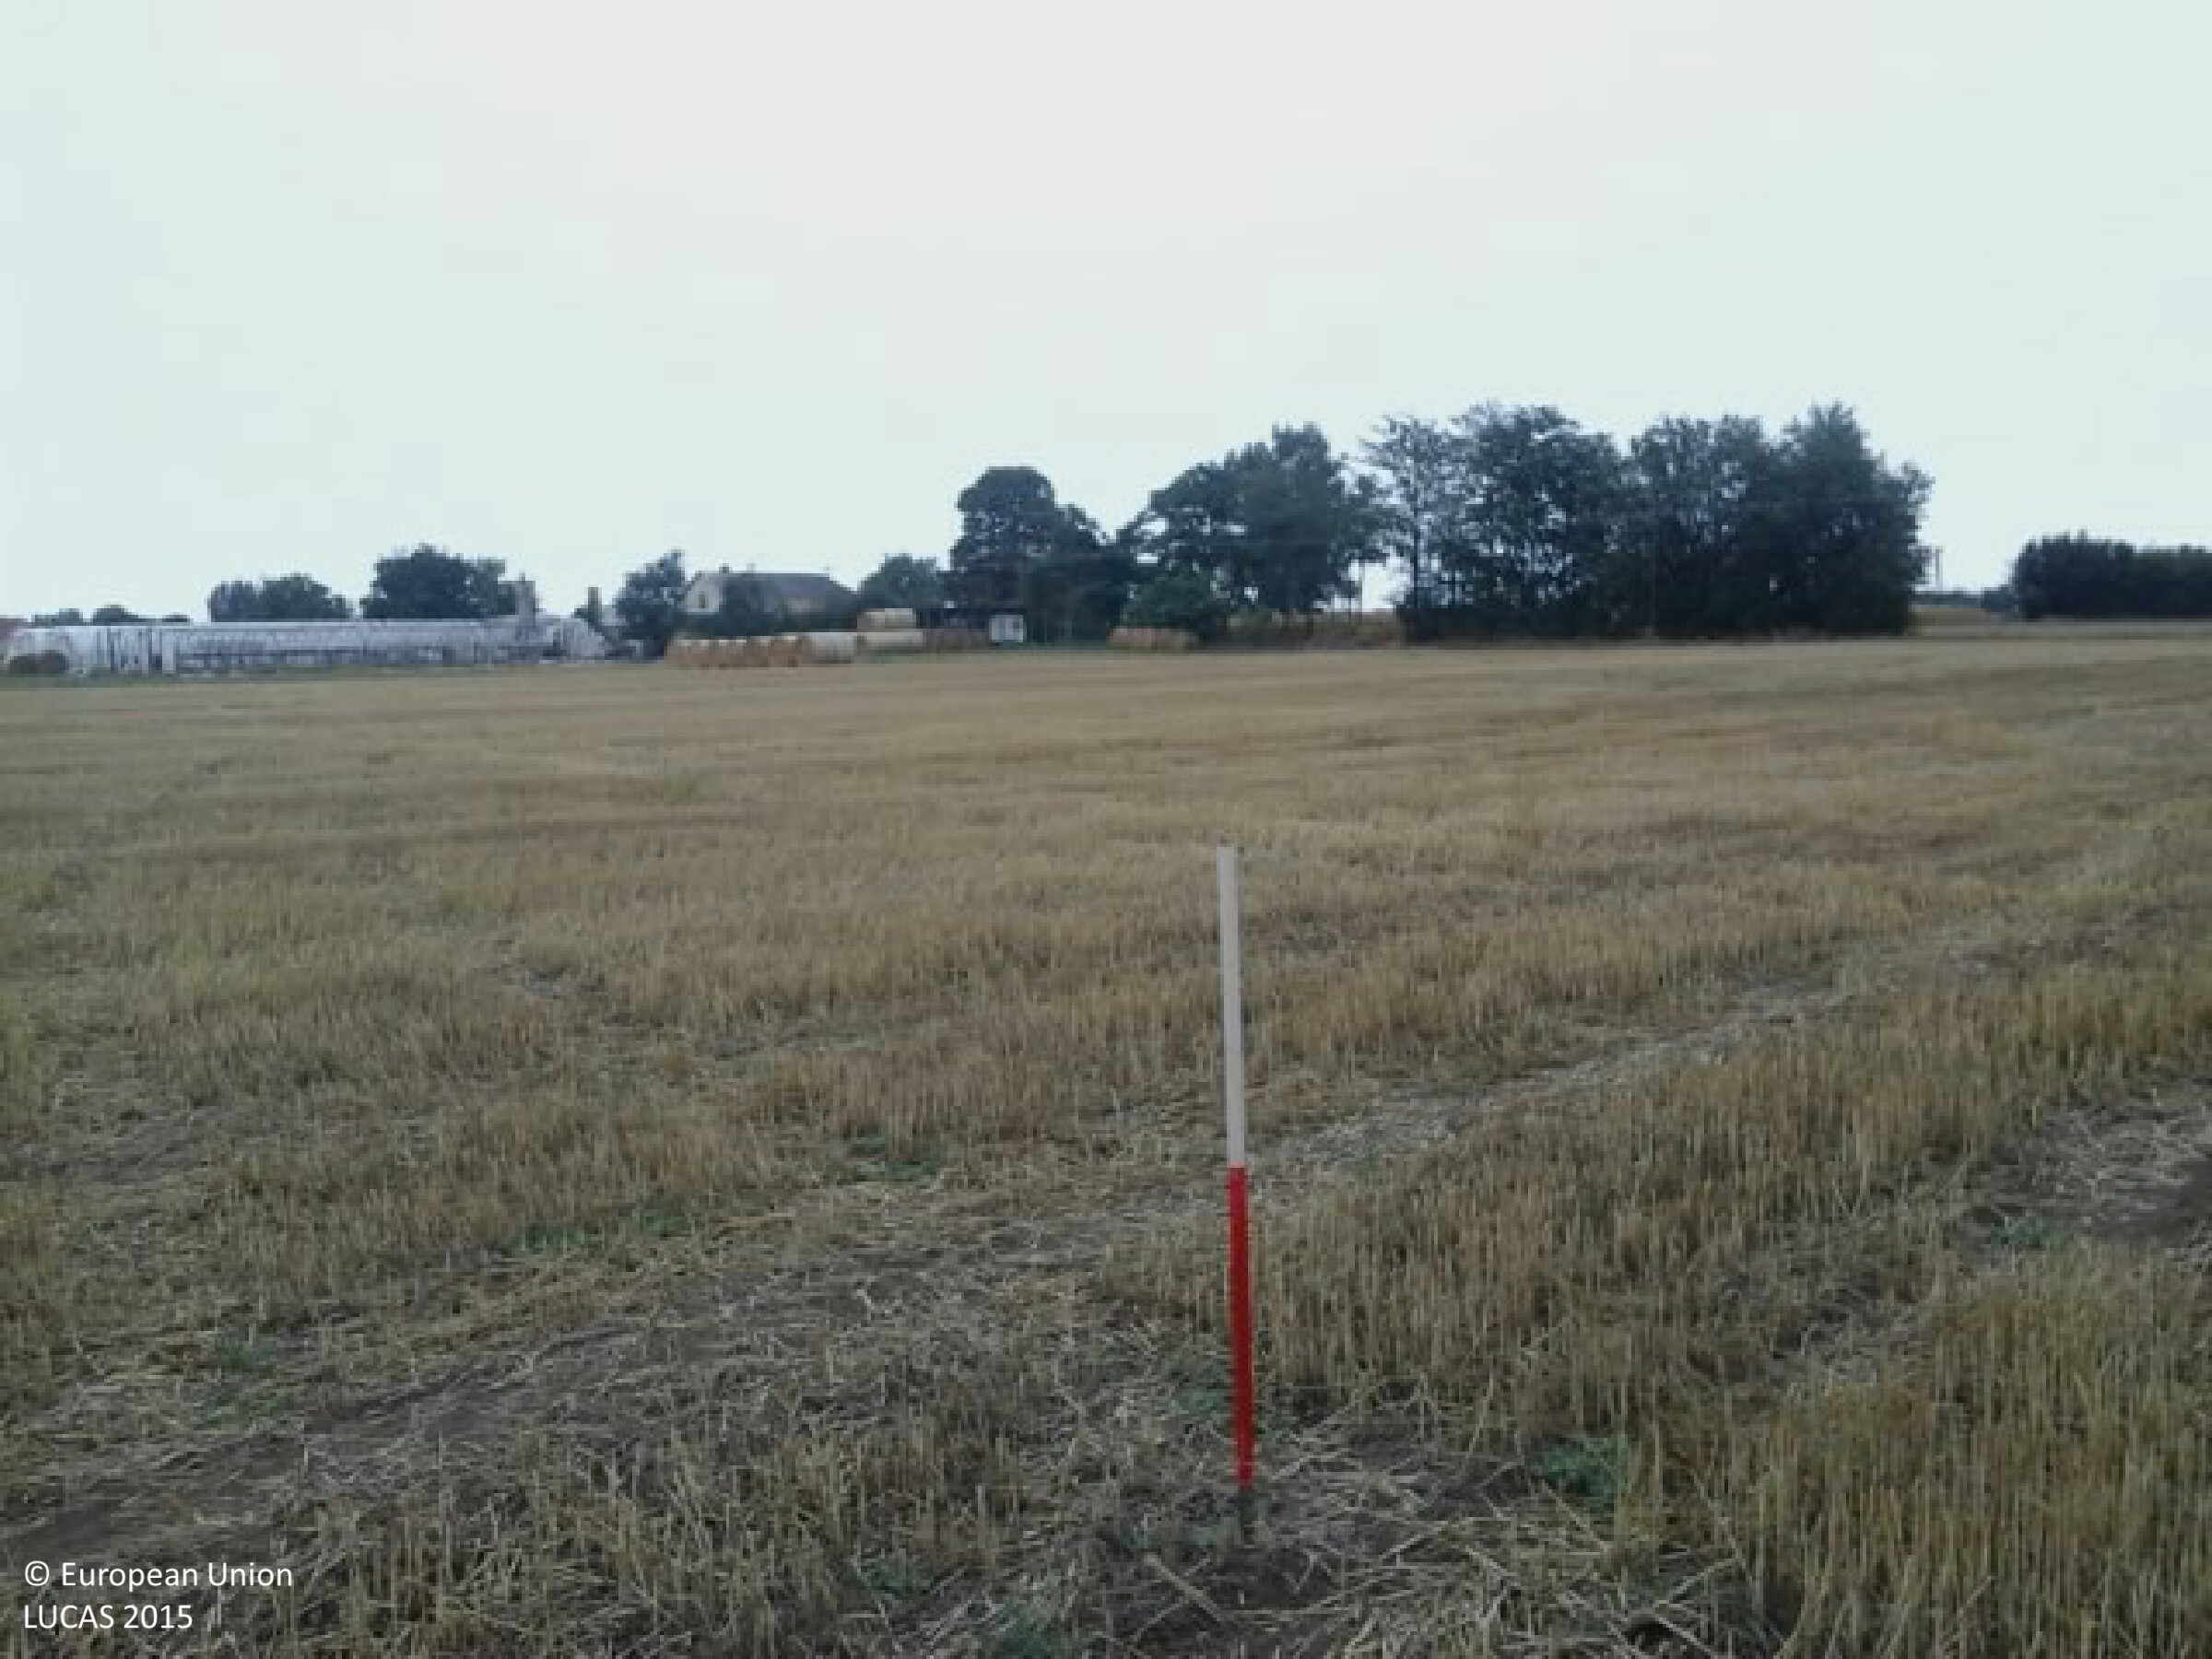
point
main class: Cropland
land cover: Common wheat
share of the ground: 10 - 25 %
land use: Agriculture (excluding fallow land and kitchen gardens)
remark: Harvested field
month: July
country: HU
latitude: 47.0425
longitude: 19.8013
